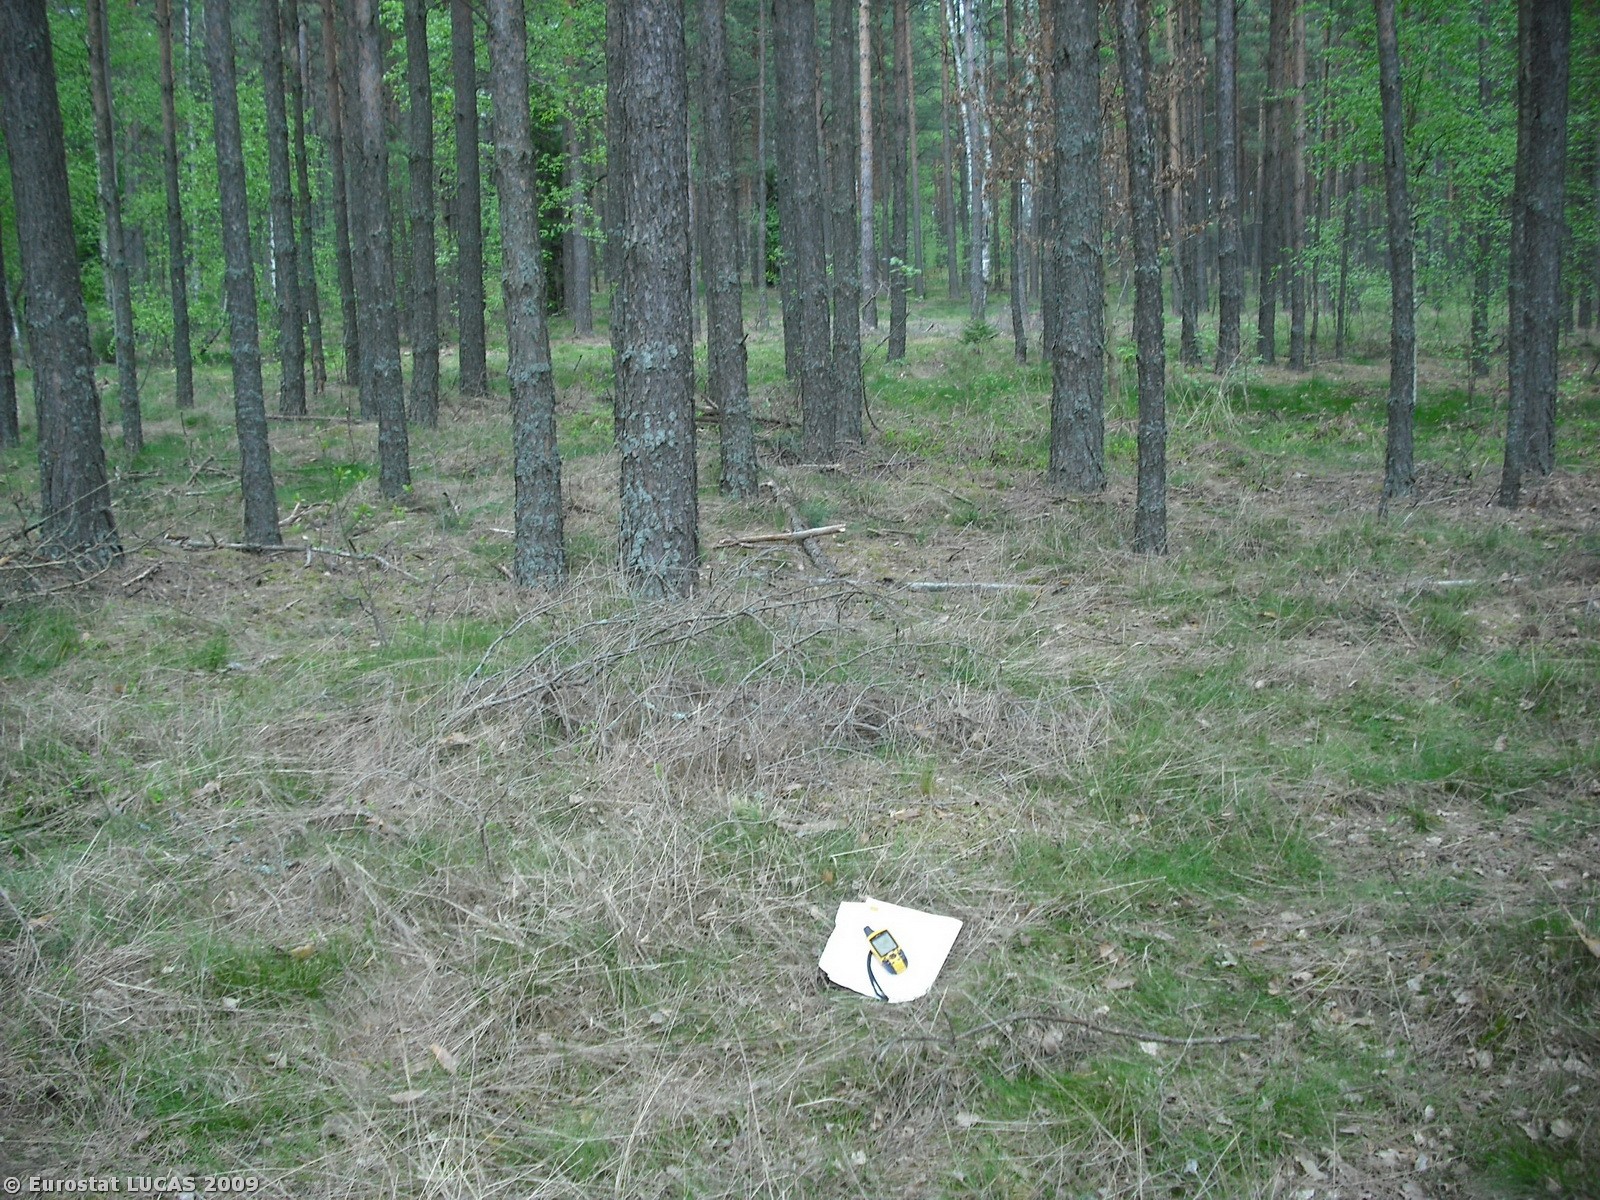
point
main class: Woodland
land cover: Mixed woodland
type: hemiboreal forest and nemoral coniferous forest and mixed broadleaved-coniferous forest
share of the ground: 50 - 75 %
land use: Forestry
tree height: > 5 m
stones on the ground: < 10 %
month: August
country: PL
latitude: 53.1039
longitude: 23.6036
